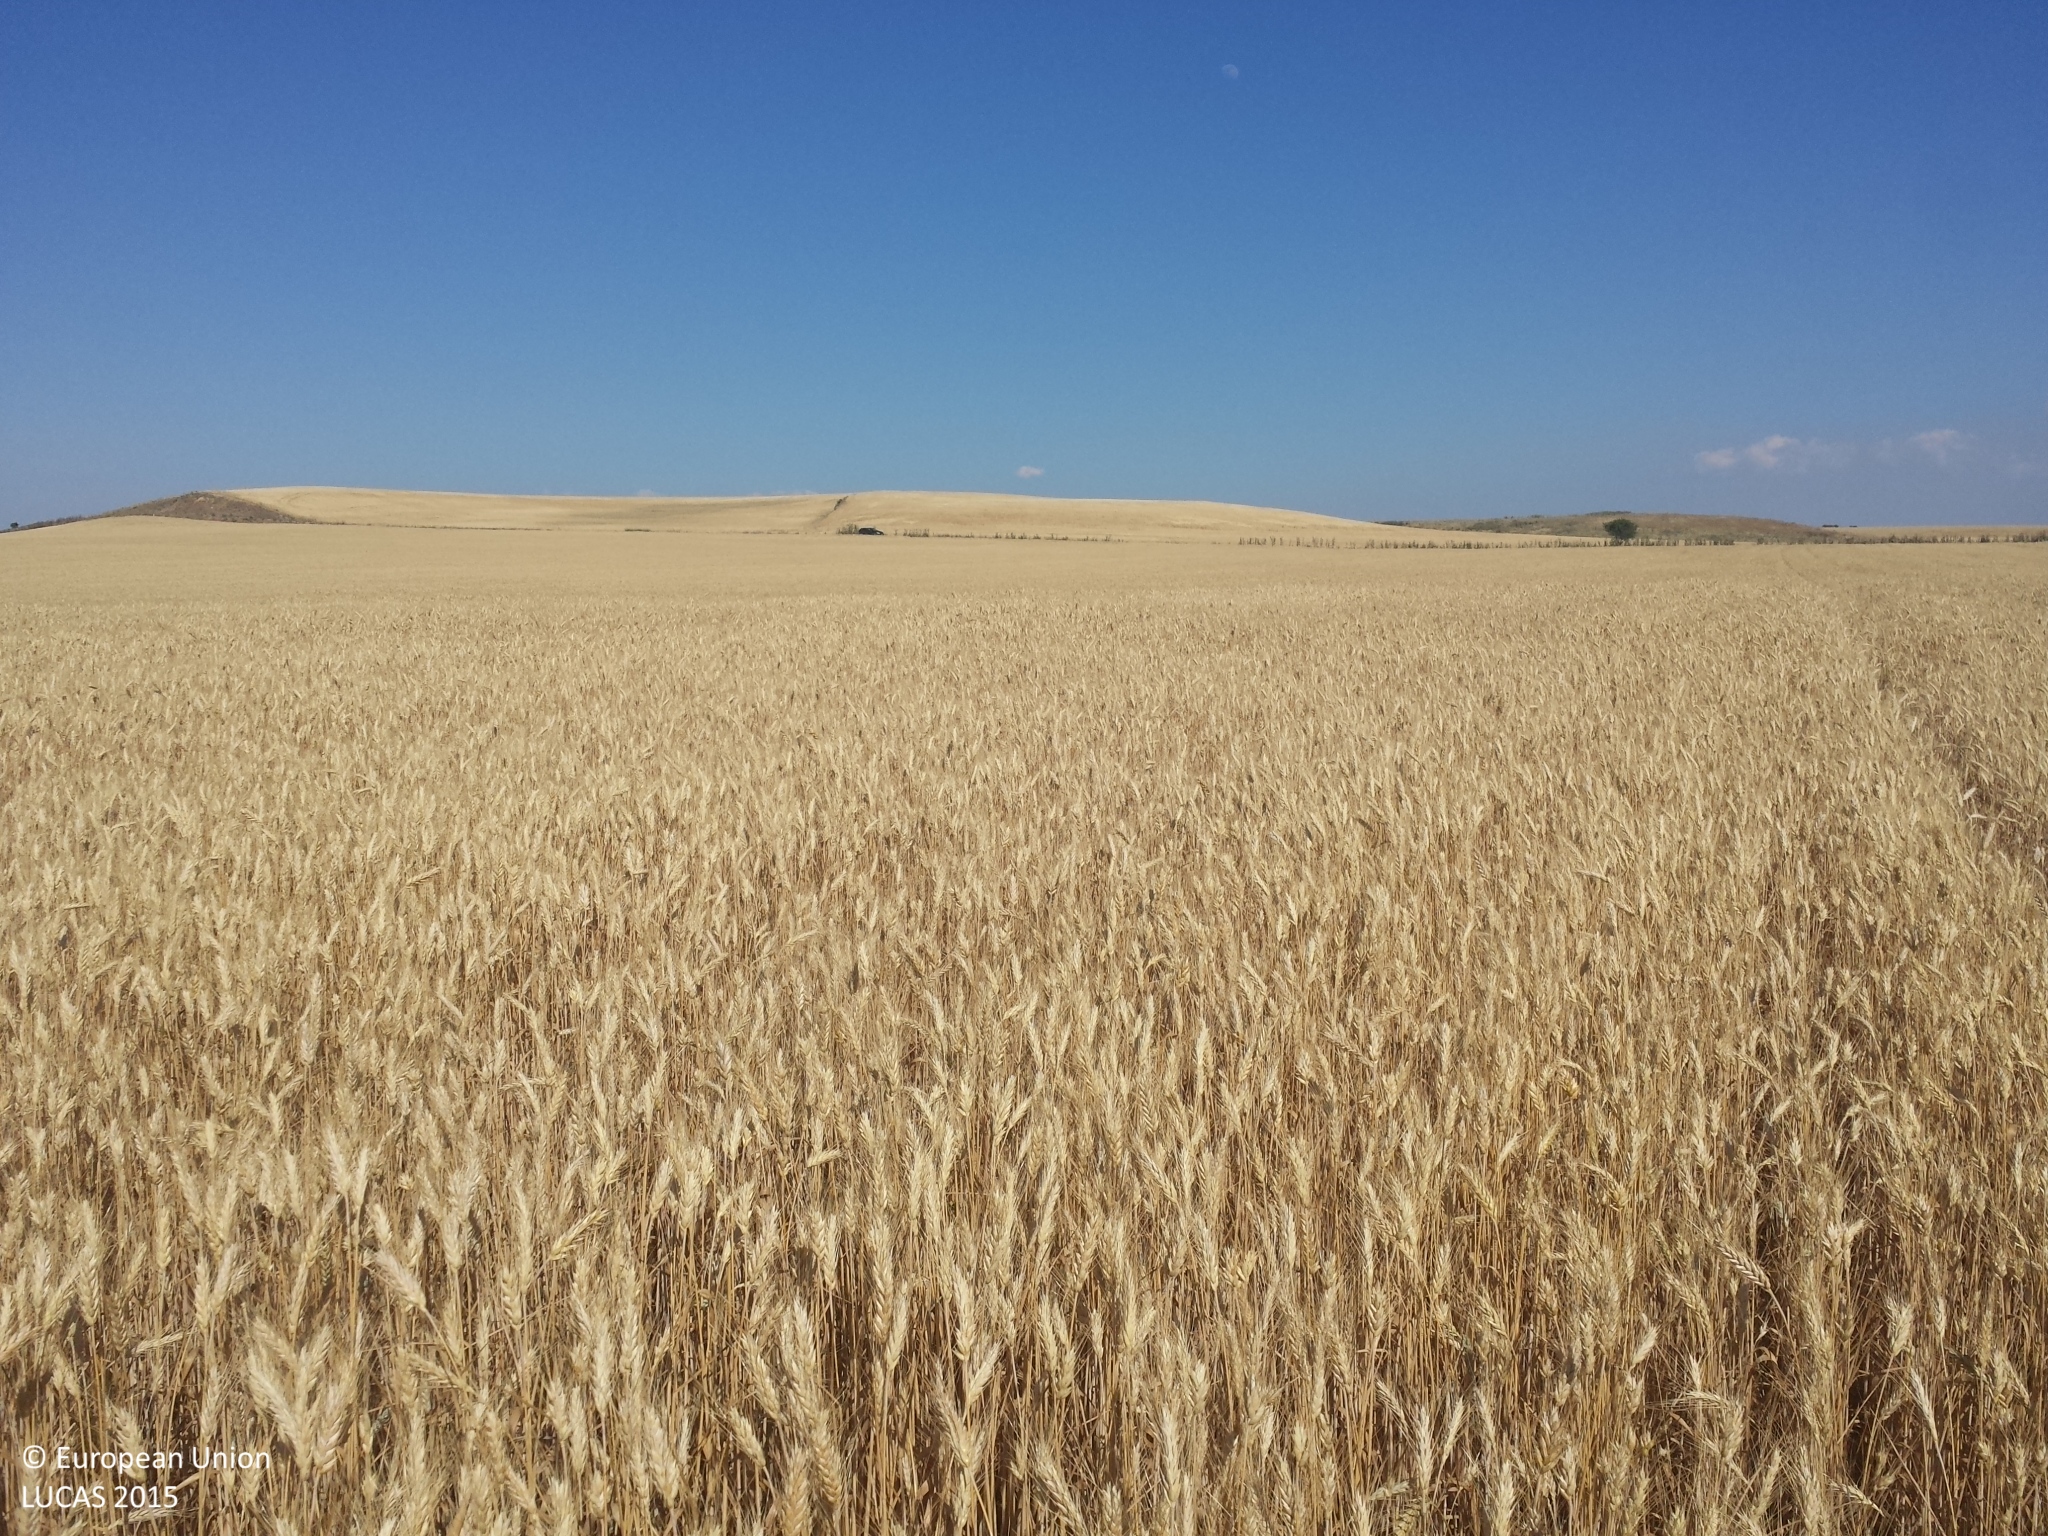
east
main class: Cropland
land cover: Common wheat
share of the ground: > 75 %
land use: Agriculture (excluding fallow land and kitchen gardens)
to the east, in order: Common wheat
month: May
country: ES
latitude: 41.7206
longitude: 0.5505
